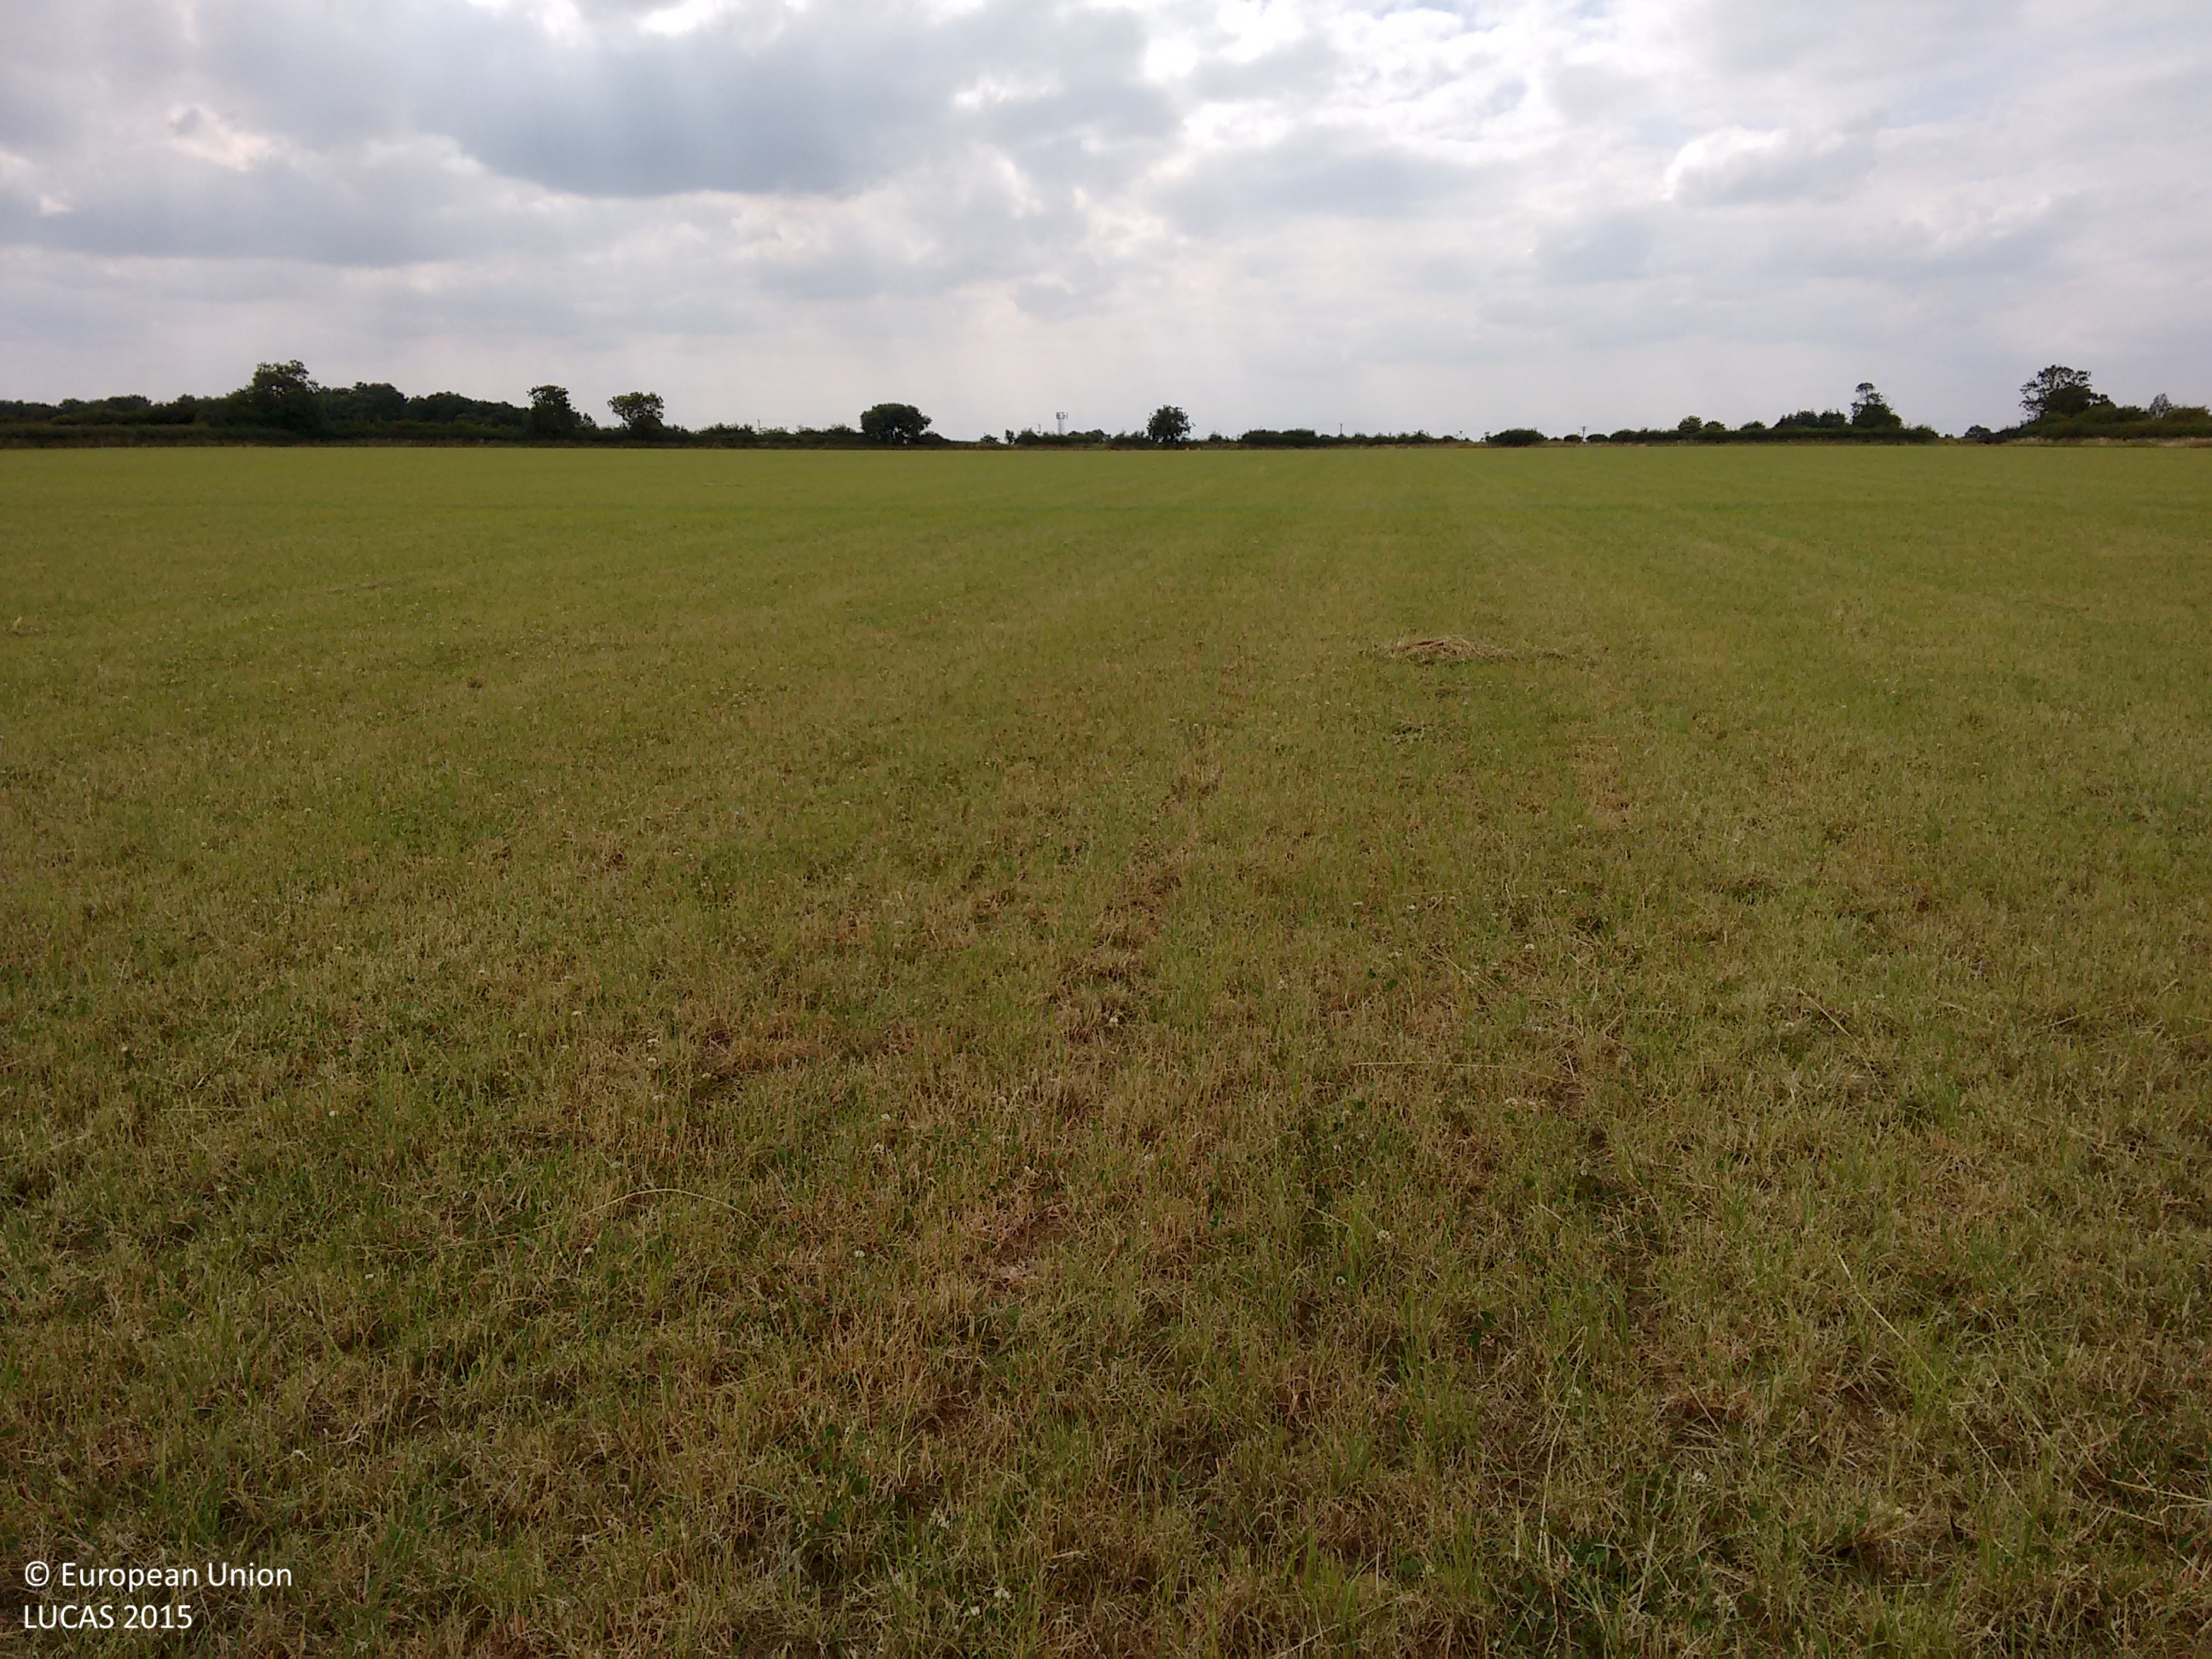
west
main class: Grassland
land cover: Grassland without tree/shrub cover
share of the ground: > 75 %
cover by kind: herbaceous plants 100 %
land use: Agriculture (excluding fallow land and kitchen gardens)
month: July
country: GB
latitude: 52.5781
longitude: -0.7397
